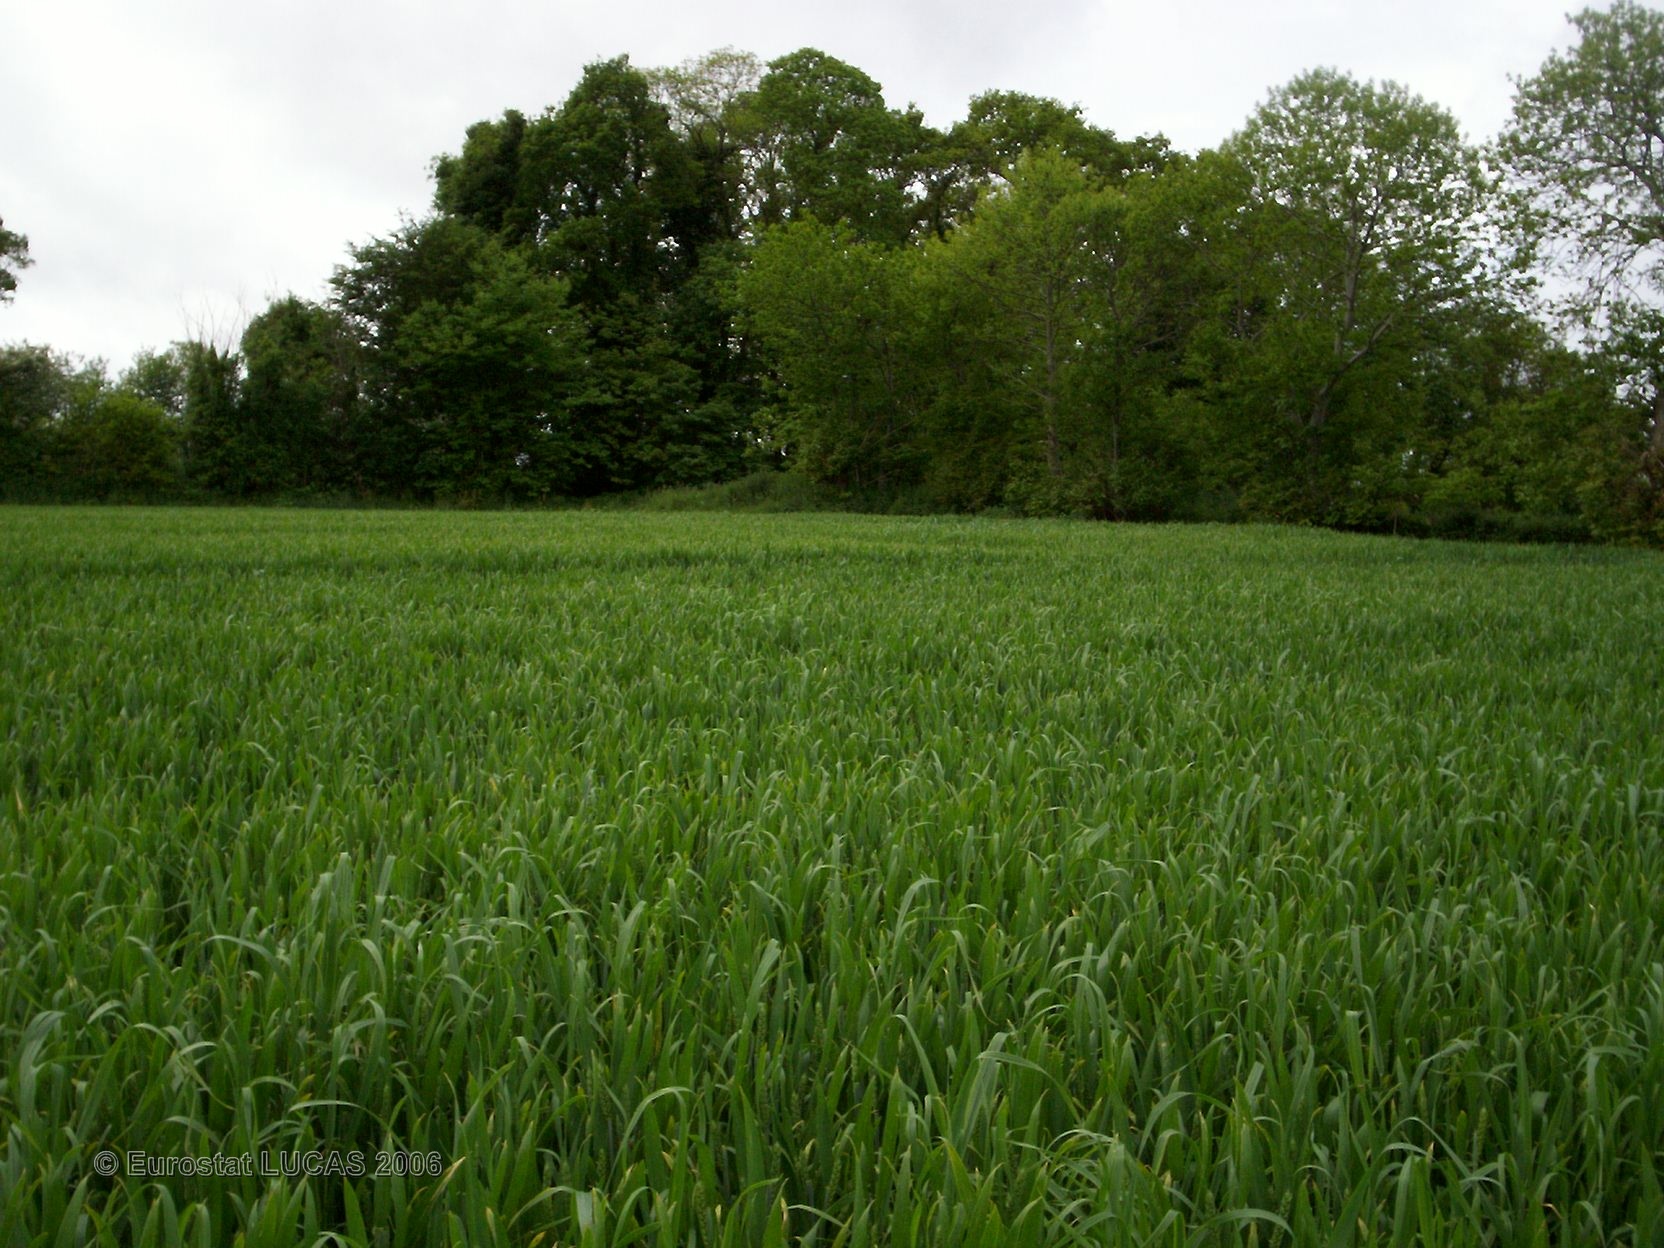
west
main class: Cropland
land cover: Common wheat
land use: Agriculture (excluding fallow land and kitchen gardens)
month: May
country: FR
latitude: 48.6309
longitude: -3.0291
